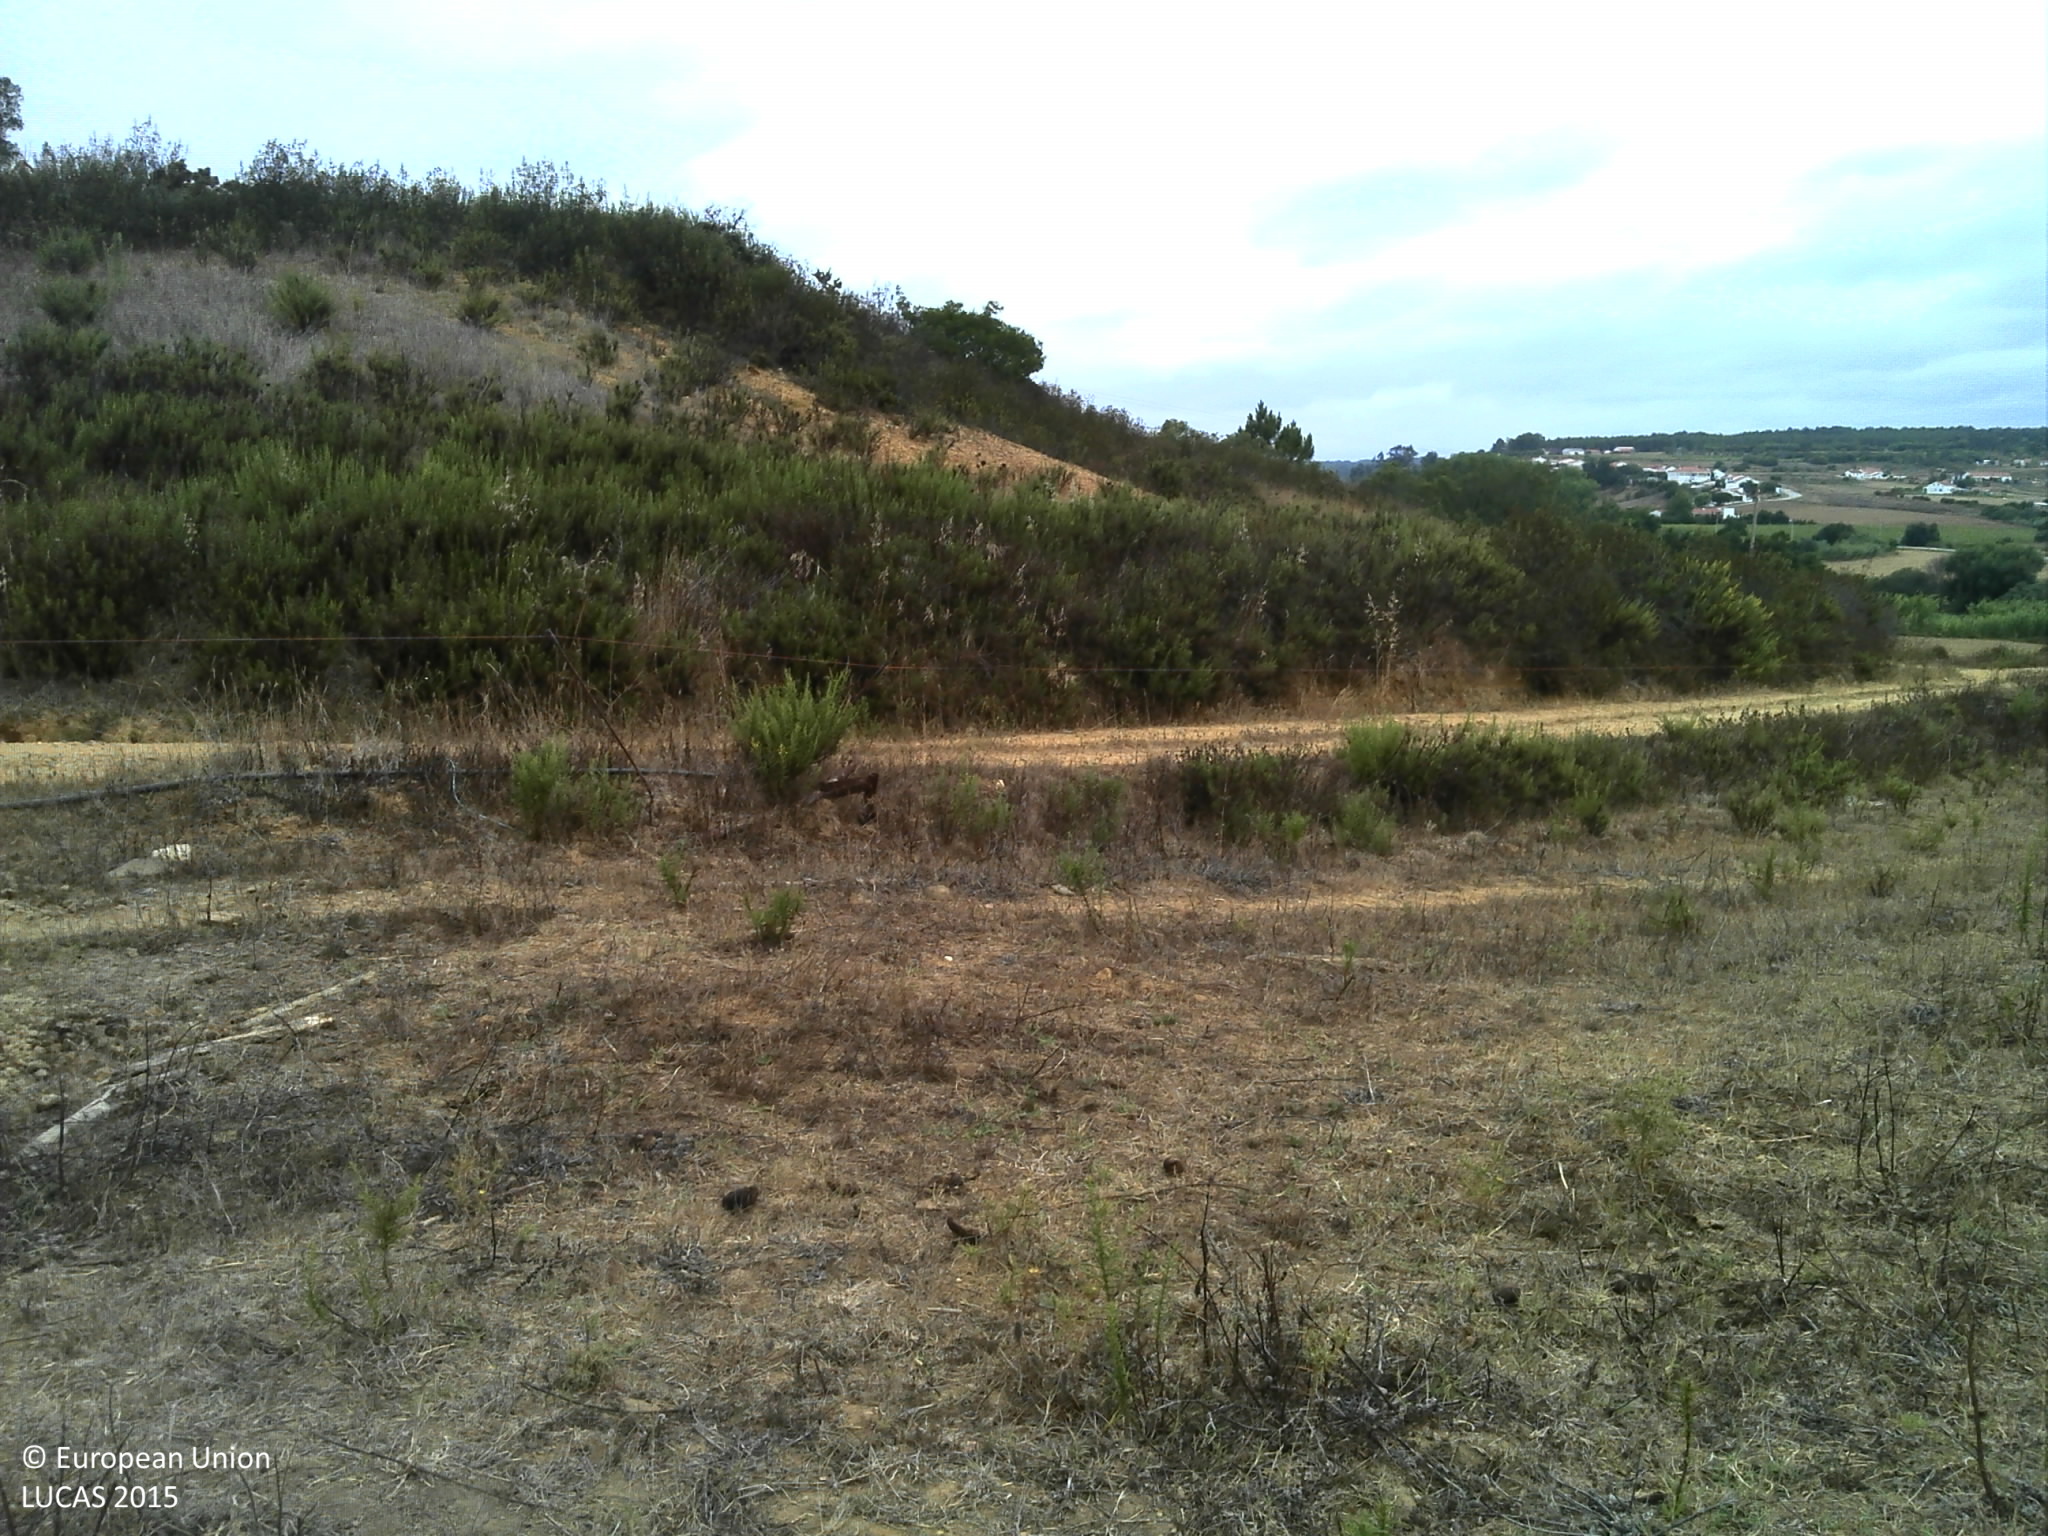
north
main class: Grassland
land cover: Grassland without tree/shrub cover
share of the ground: 25 - 50 %
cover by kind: herbaceous plants 50 %, unconsolidated bare surface 50 %
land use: Agriculture (excluding fallow land and kitchen gardens)
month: July
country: PT
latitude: 37.3411
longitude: -8.7850
